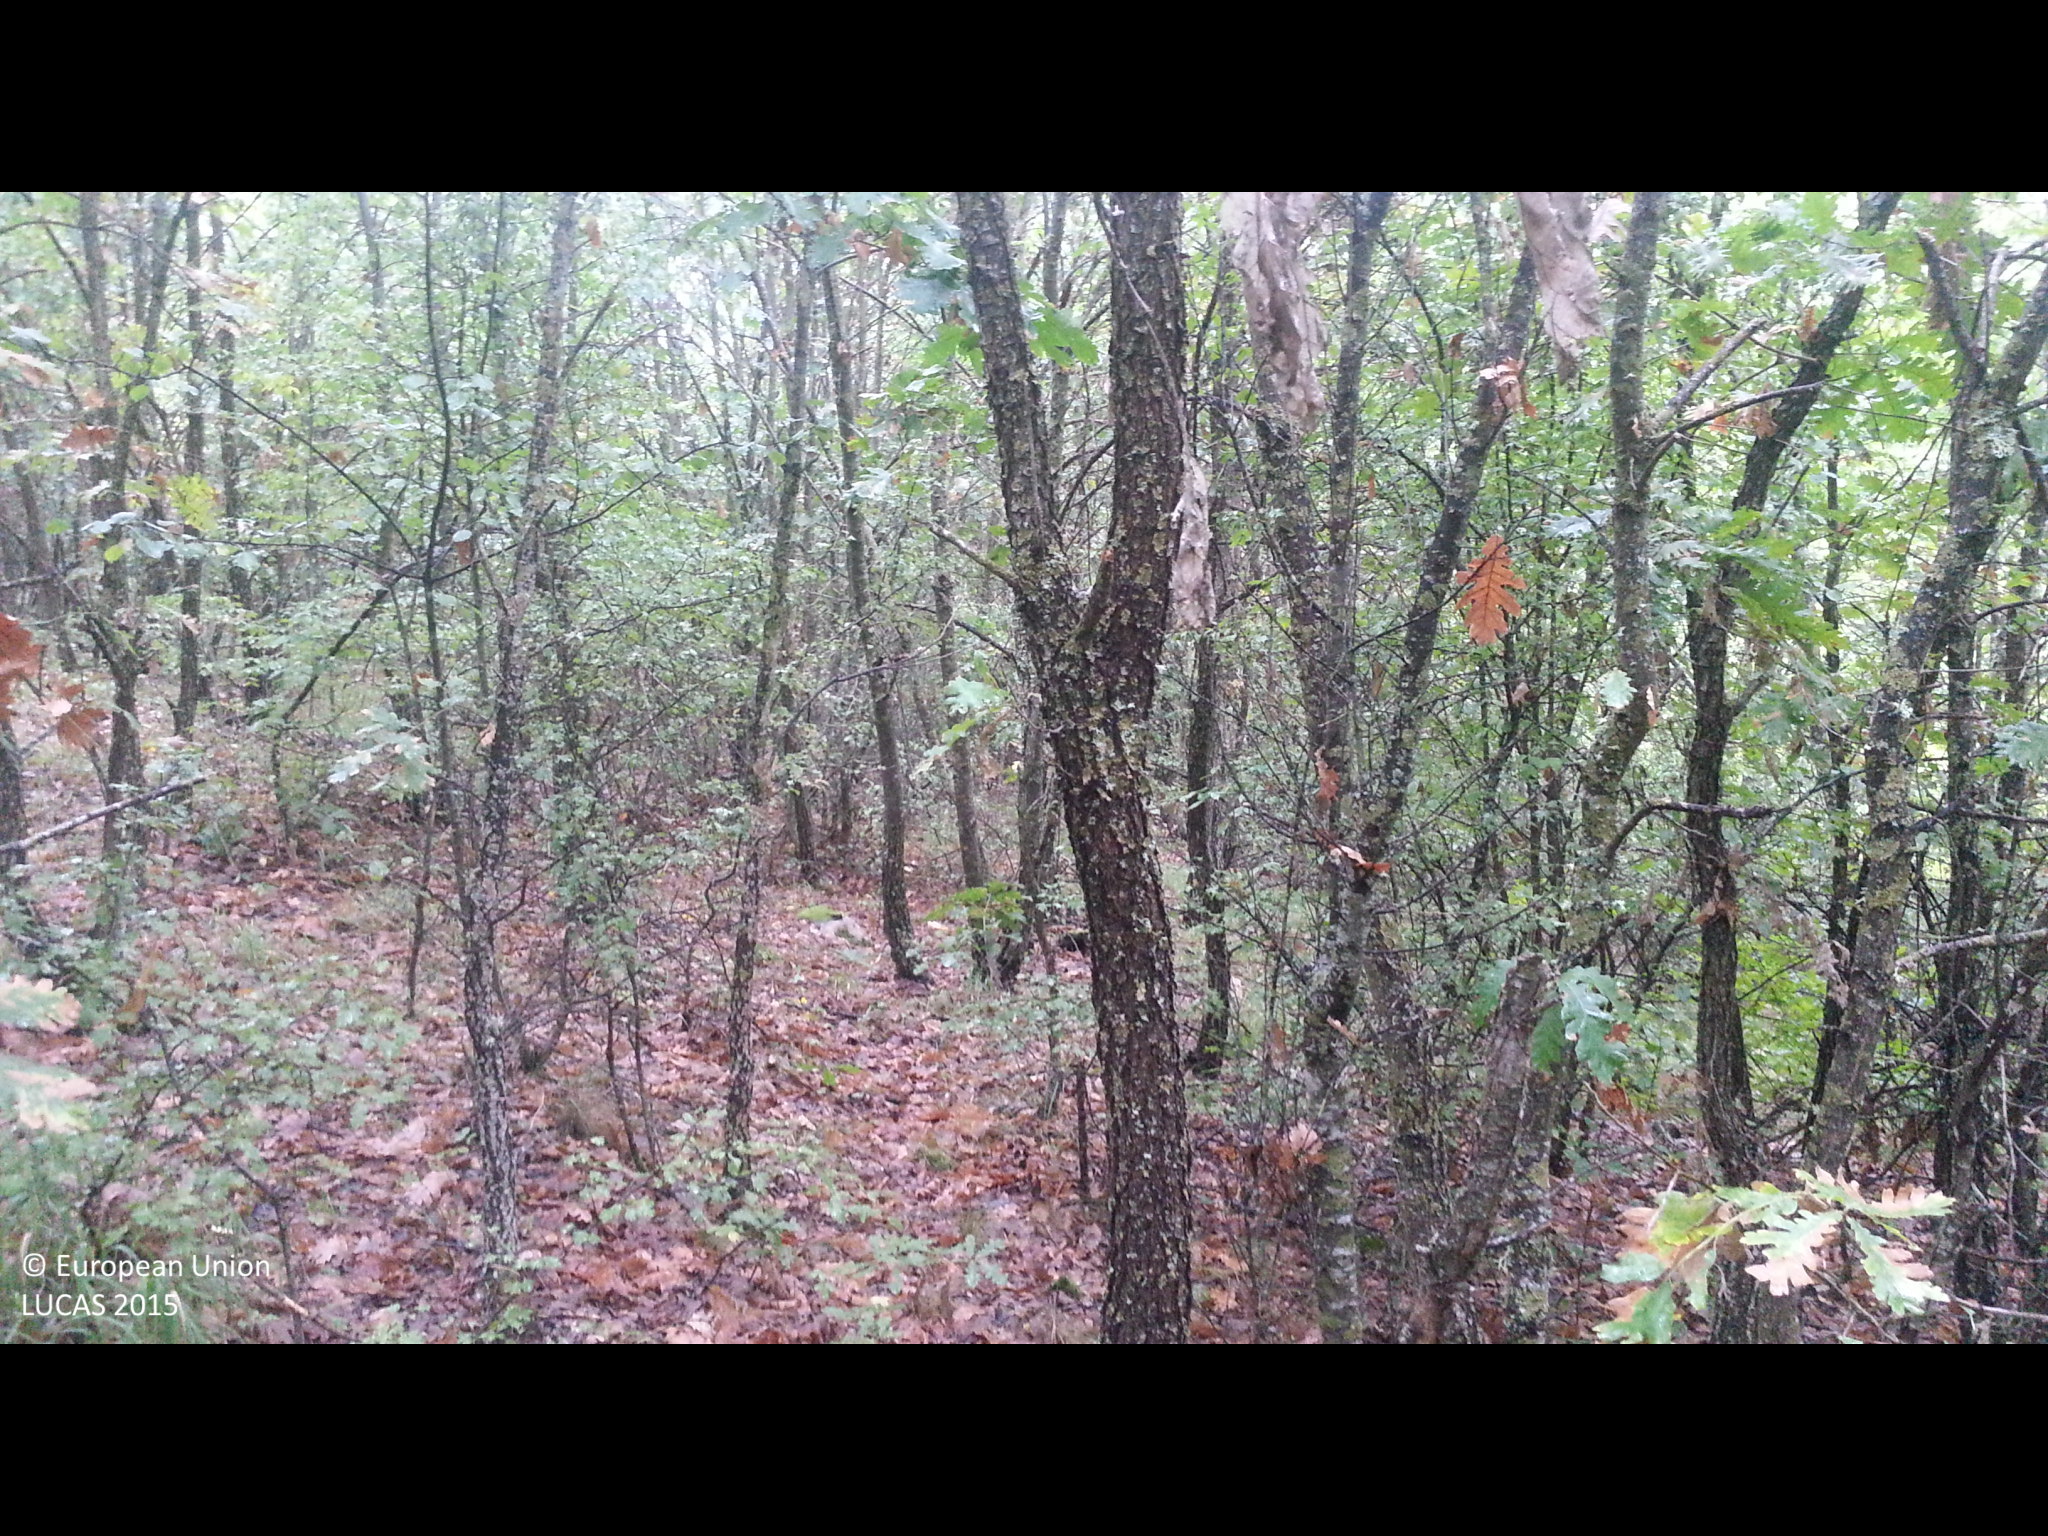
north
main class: Woodland
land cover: Broadleaved woodland
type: mesophytic deciduous forest
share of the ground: > 75 %
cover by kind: broadleaved forest trees 85 %, shrubs 15 %
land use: Forestry
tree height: < 5 m
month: September
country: BG
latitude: 42.5239
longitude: 22.7210
